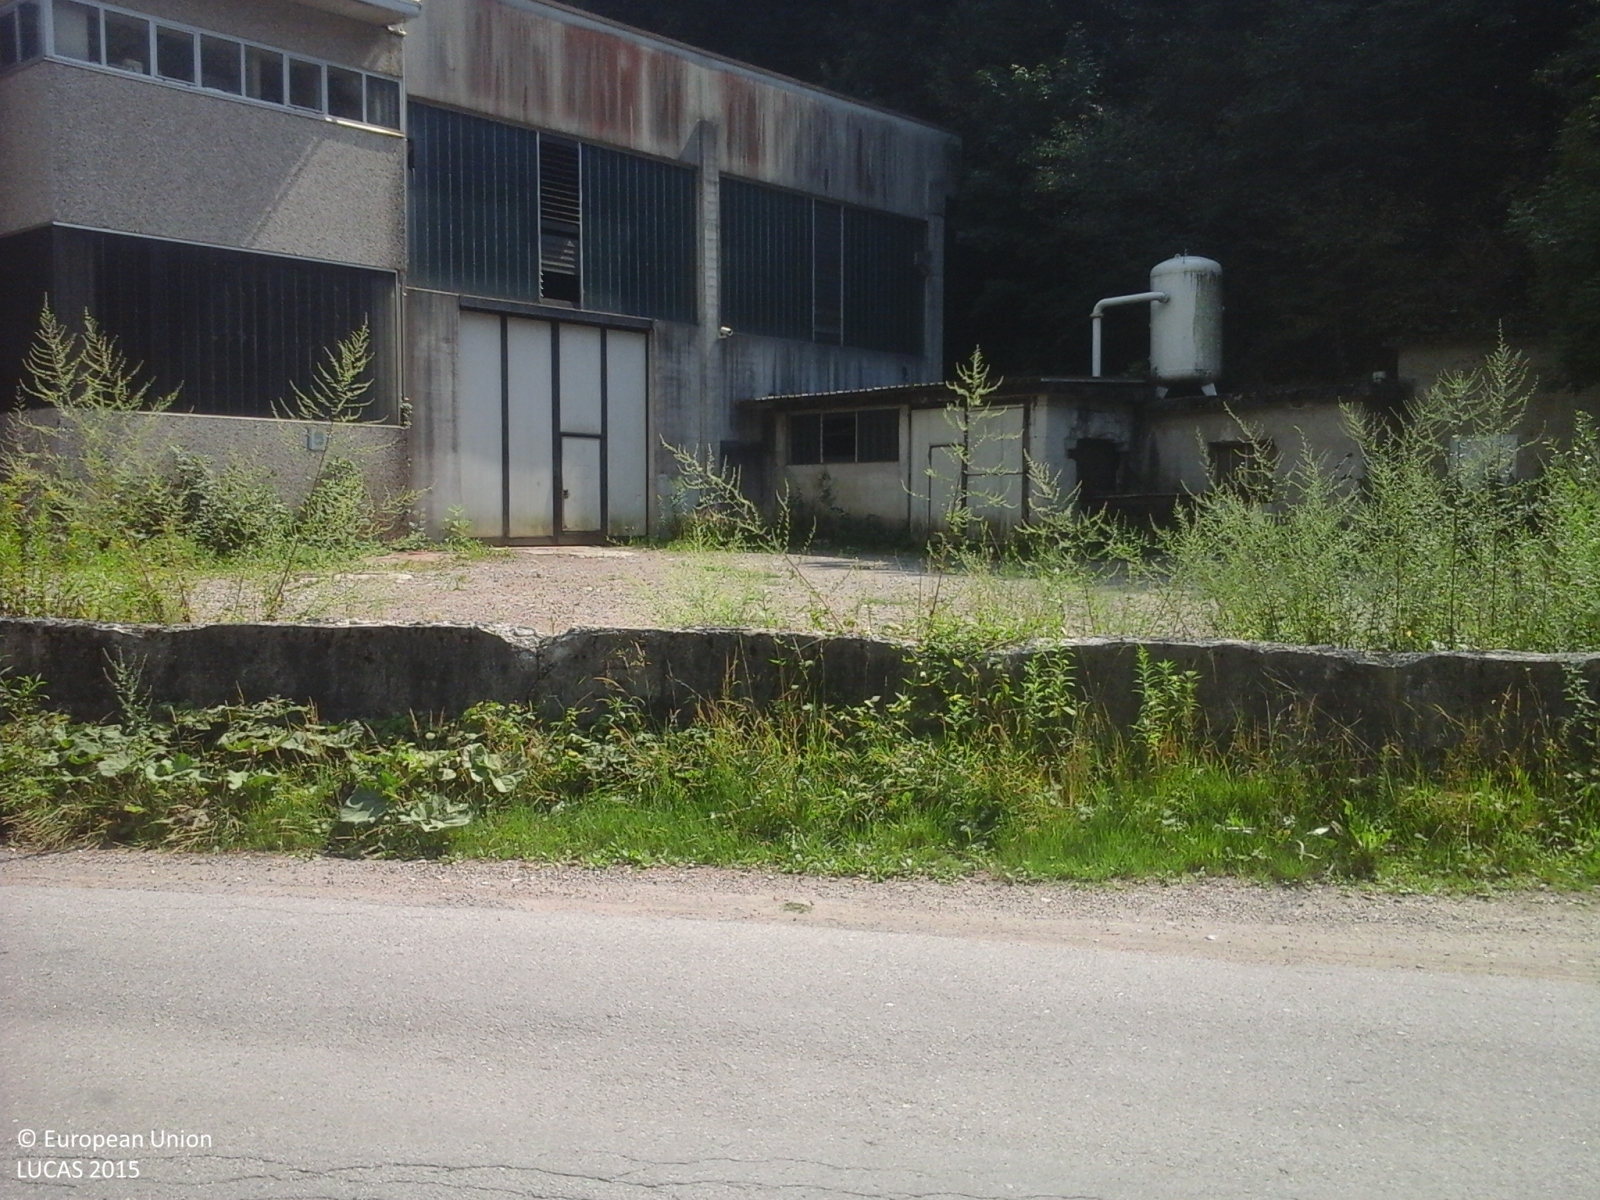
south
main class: Woodland
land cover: Broadleaved woodland
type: thermophilous deciduous forest
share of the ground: > 75 %
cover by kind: broadleaved forest trees 100 %
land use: Forestry
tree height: > 5 m
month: August
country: IT
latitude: 45.9892
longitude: 9.3941
